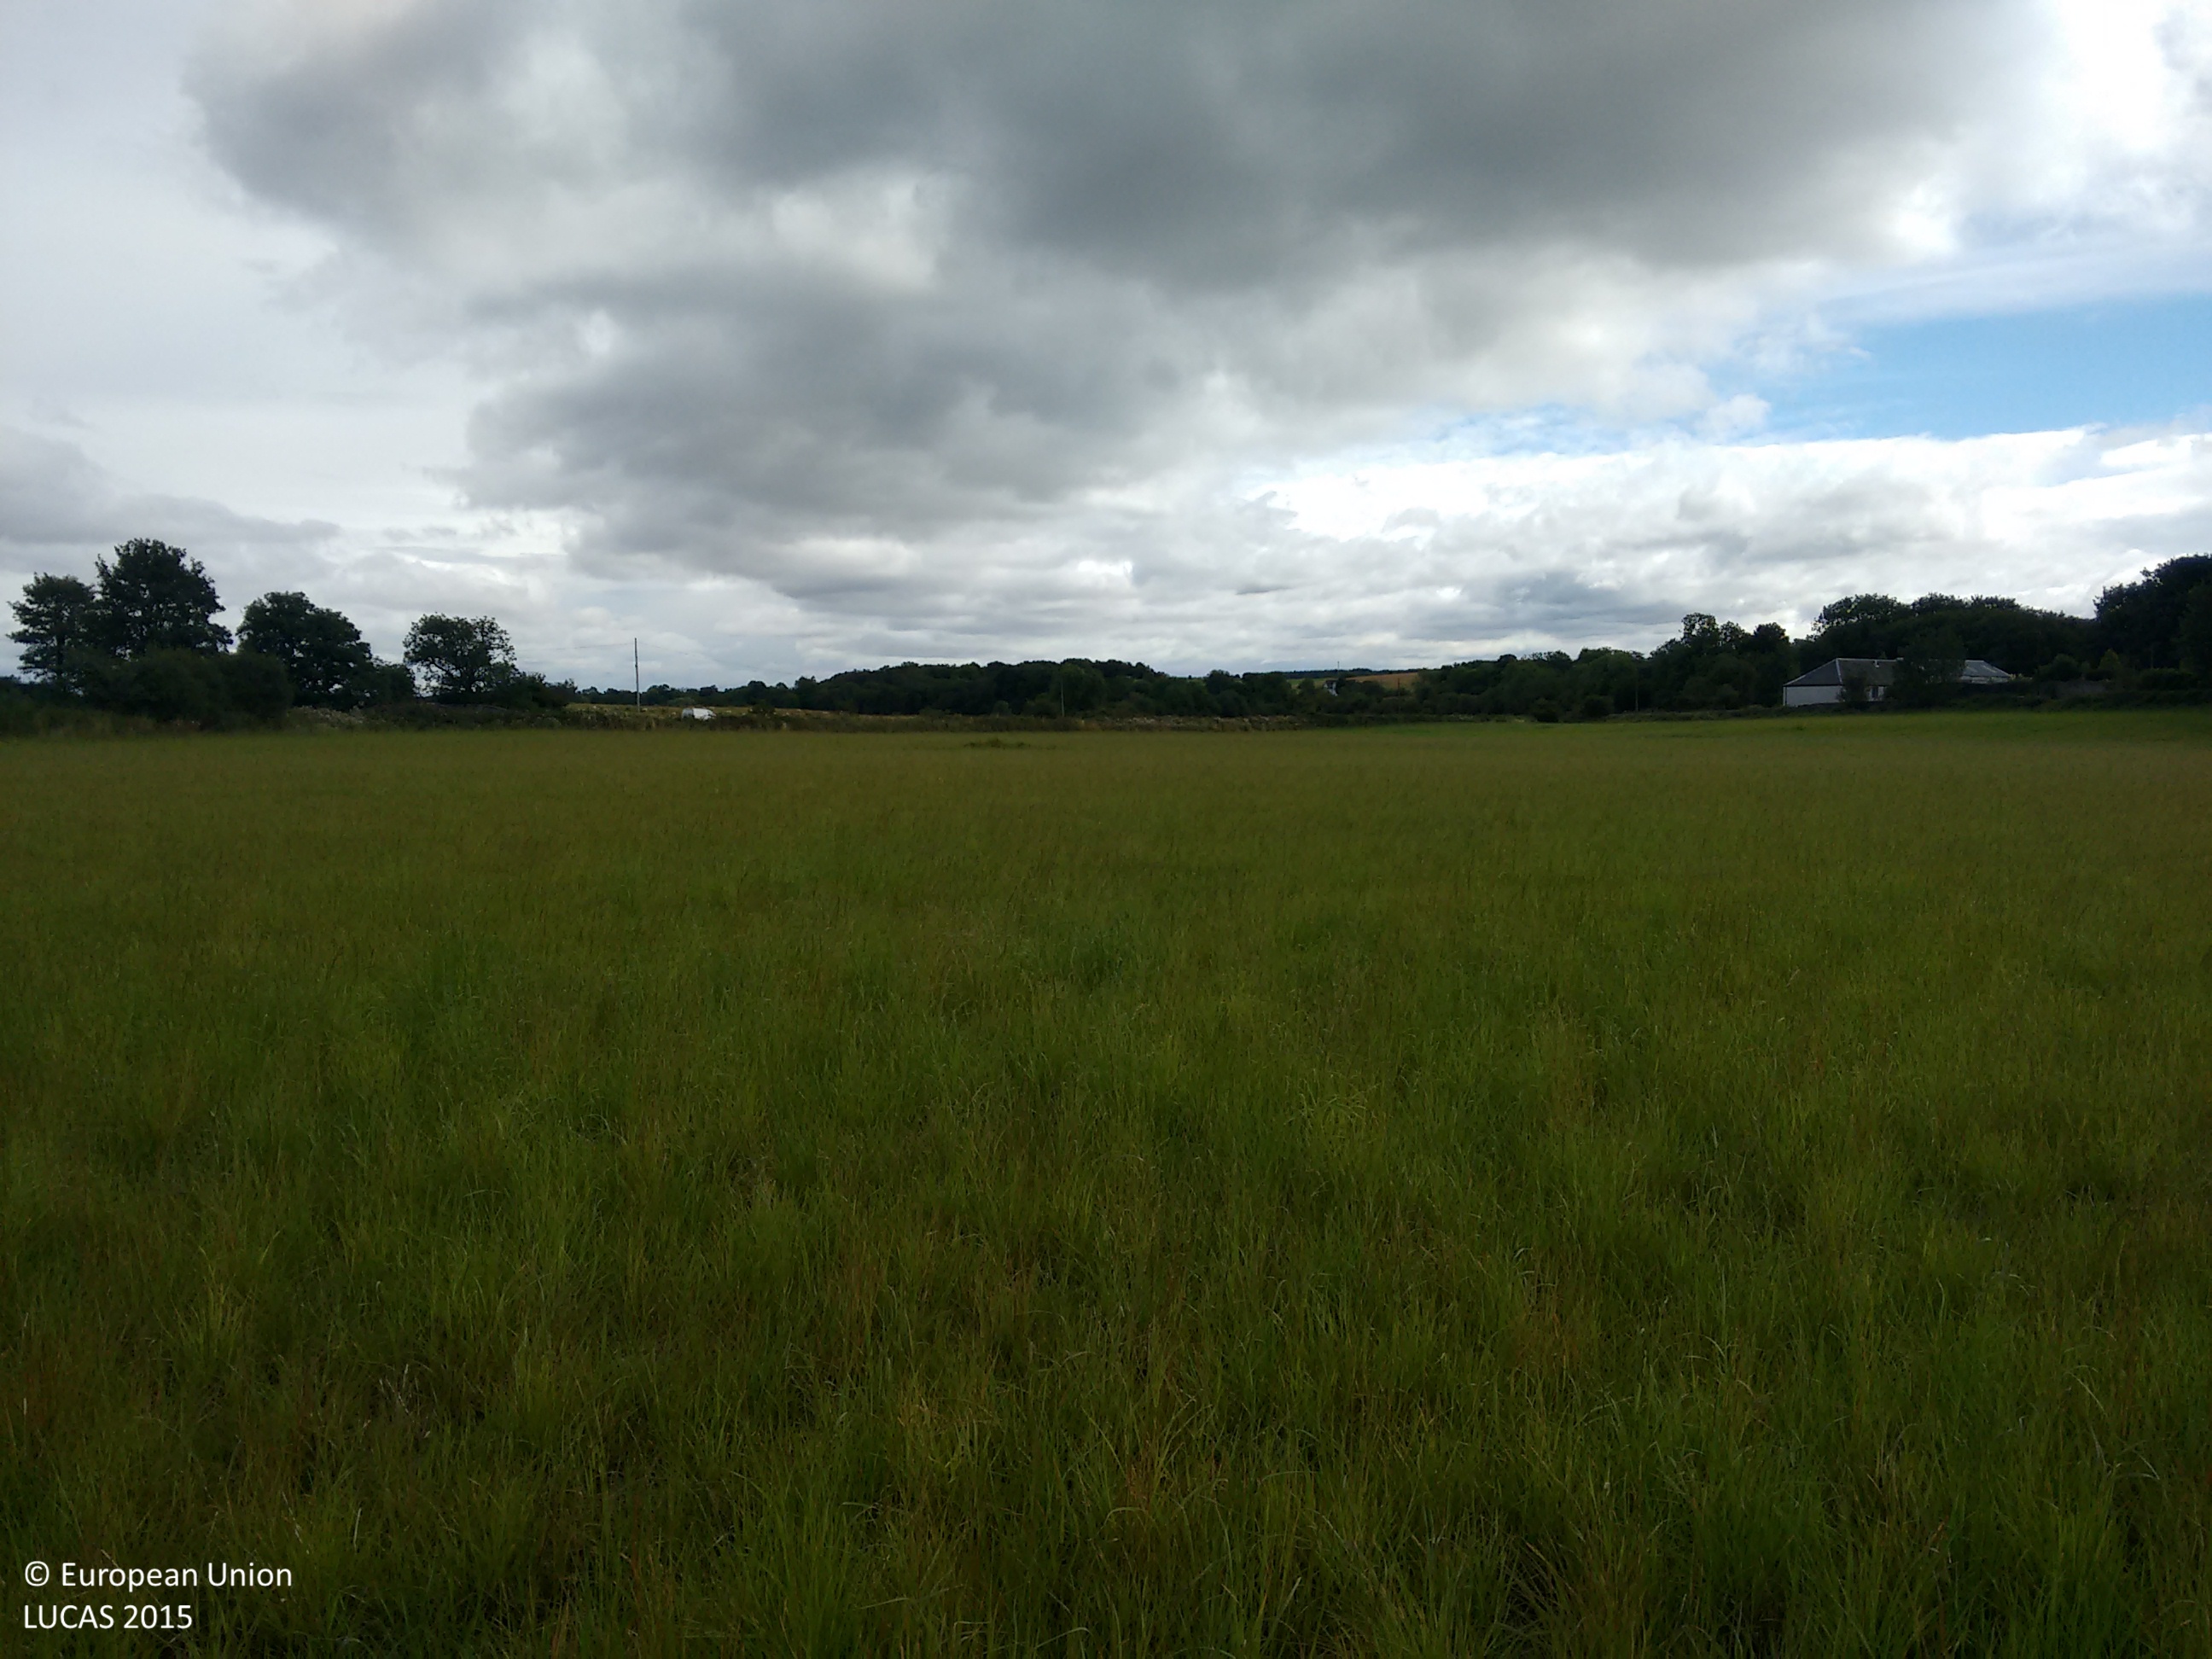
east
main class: Cropland
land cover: Temporary grasslands
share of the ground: > 75 %
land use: Agriculture (excluding fallow land and kitchen gardens)
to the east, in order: Temporary grasslands; Grass margins; Dry stone walls; Electric lines; Grass margins; Paved roads, cycling and walking lanes; Grass margins; Dry stone walls; Grass margins; Barley
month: September
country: GB
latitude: 55.9905
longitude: -3.9202
